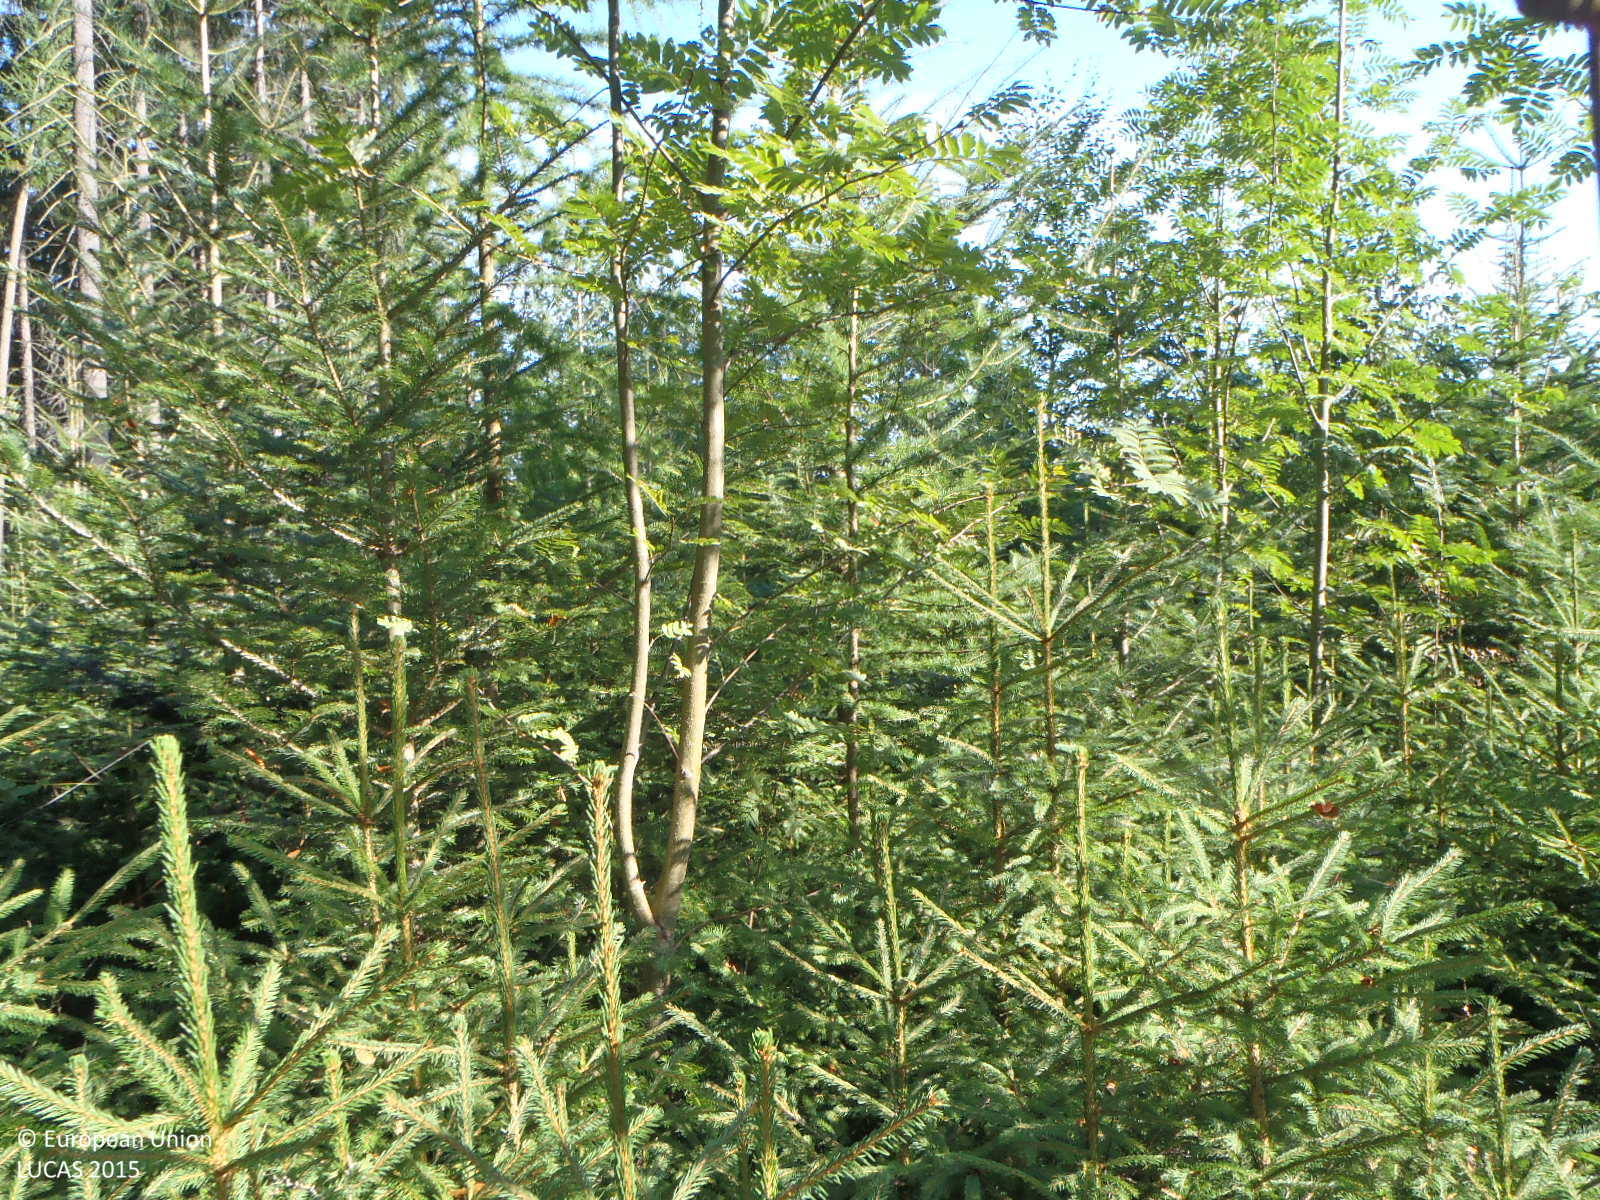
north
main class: Woodland
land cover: Other mixed woodland
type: hemiboreal forest and nemoral coniferous forest and mixed broadleaved-coniferous forest
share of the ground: > 75 %
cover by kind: coniferous forest trees 70 %, broadleaved forest trees 30 %
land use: Forestry
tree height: < 5 m
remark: Nursery
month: August
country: CZ
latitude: 50.8483
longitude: 14.5897
